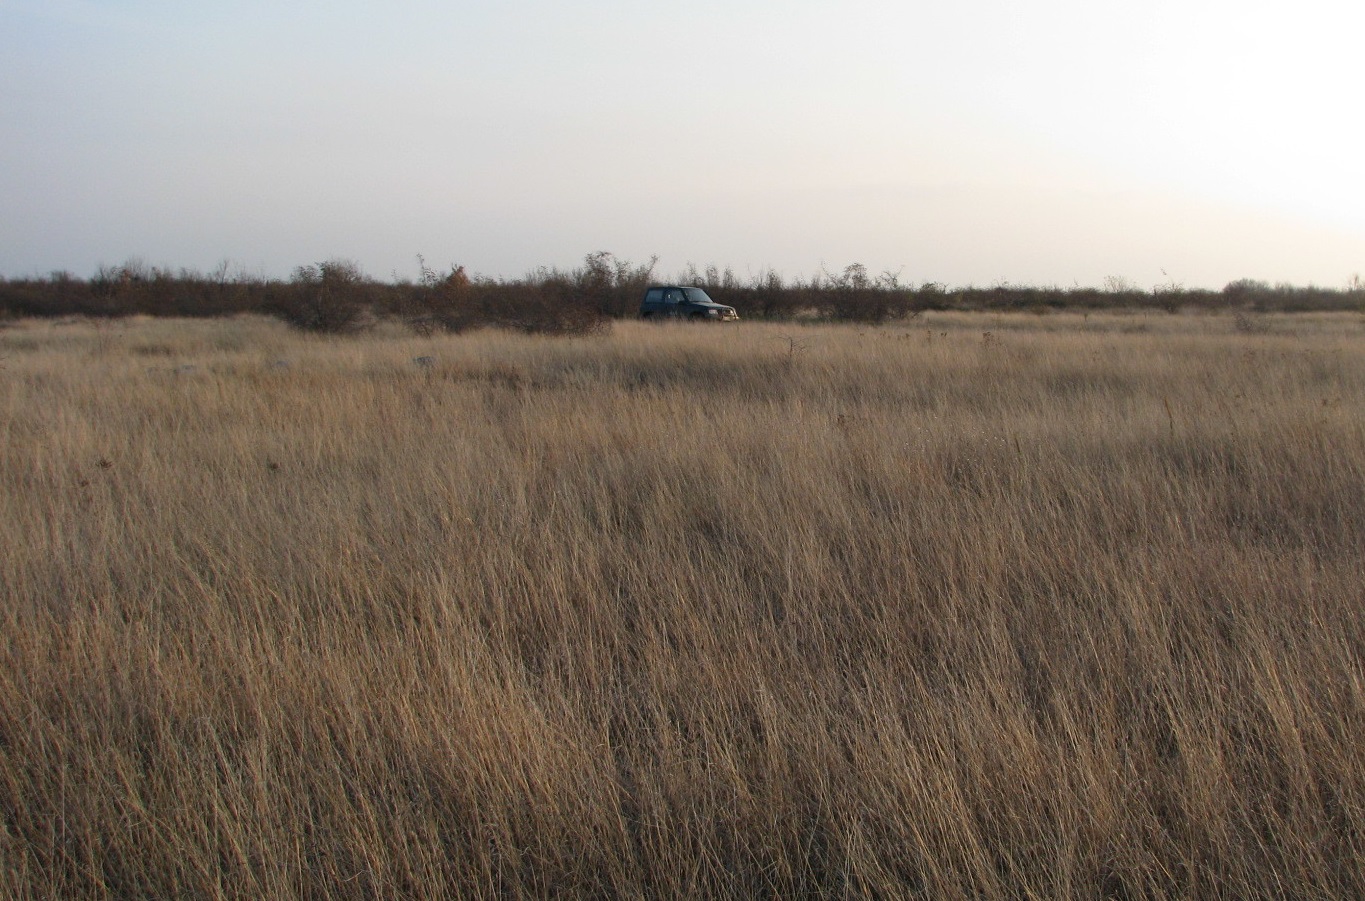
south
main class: Grassland
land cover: Grassland without tree/shrub cover
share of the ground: > 75 %
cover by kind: herbaceous plants 100 %
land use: Agriculture (excluding fallow land and kitchen gardens)
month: December
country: BG
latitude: 42.2645
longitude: 24.2402
